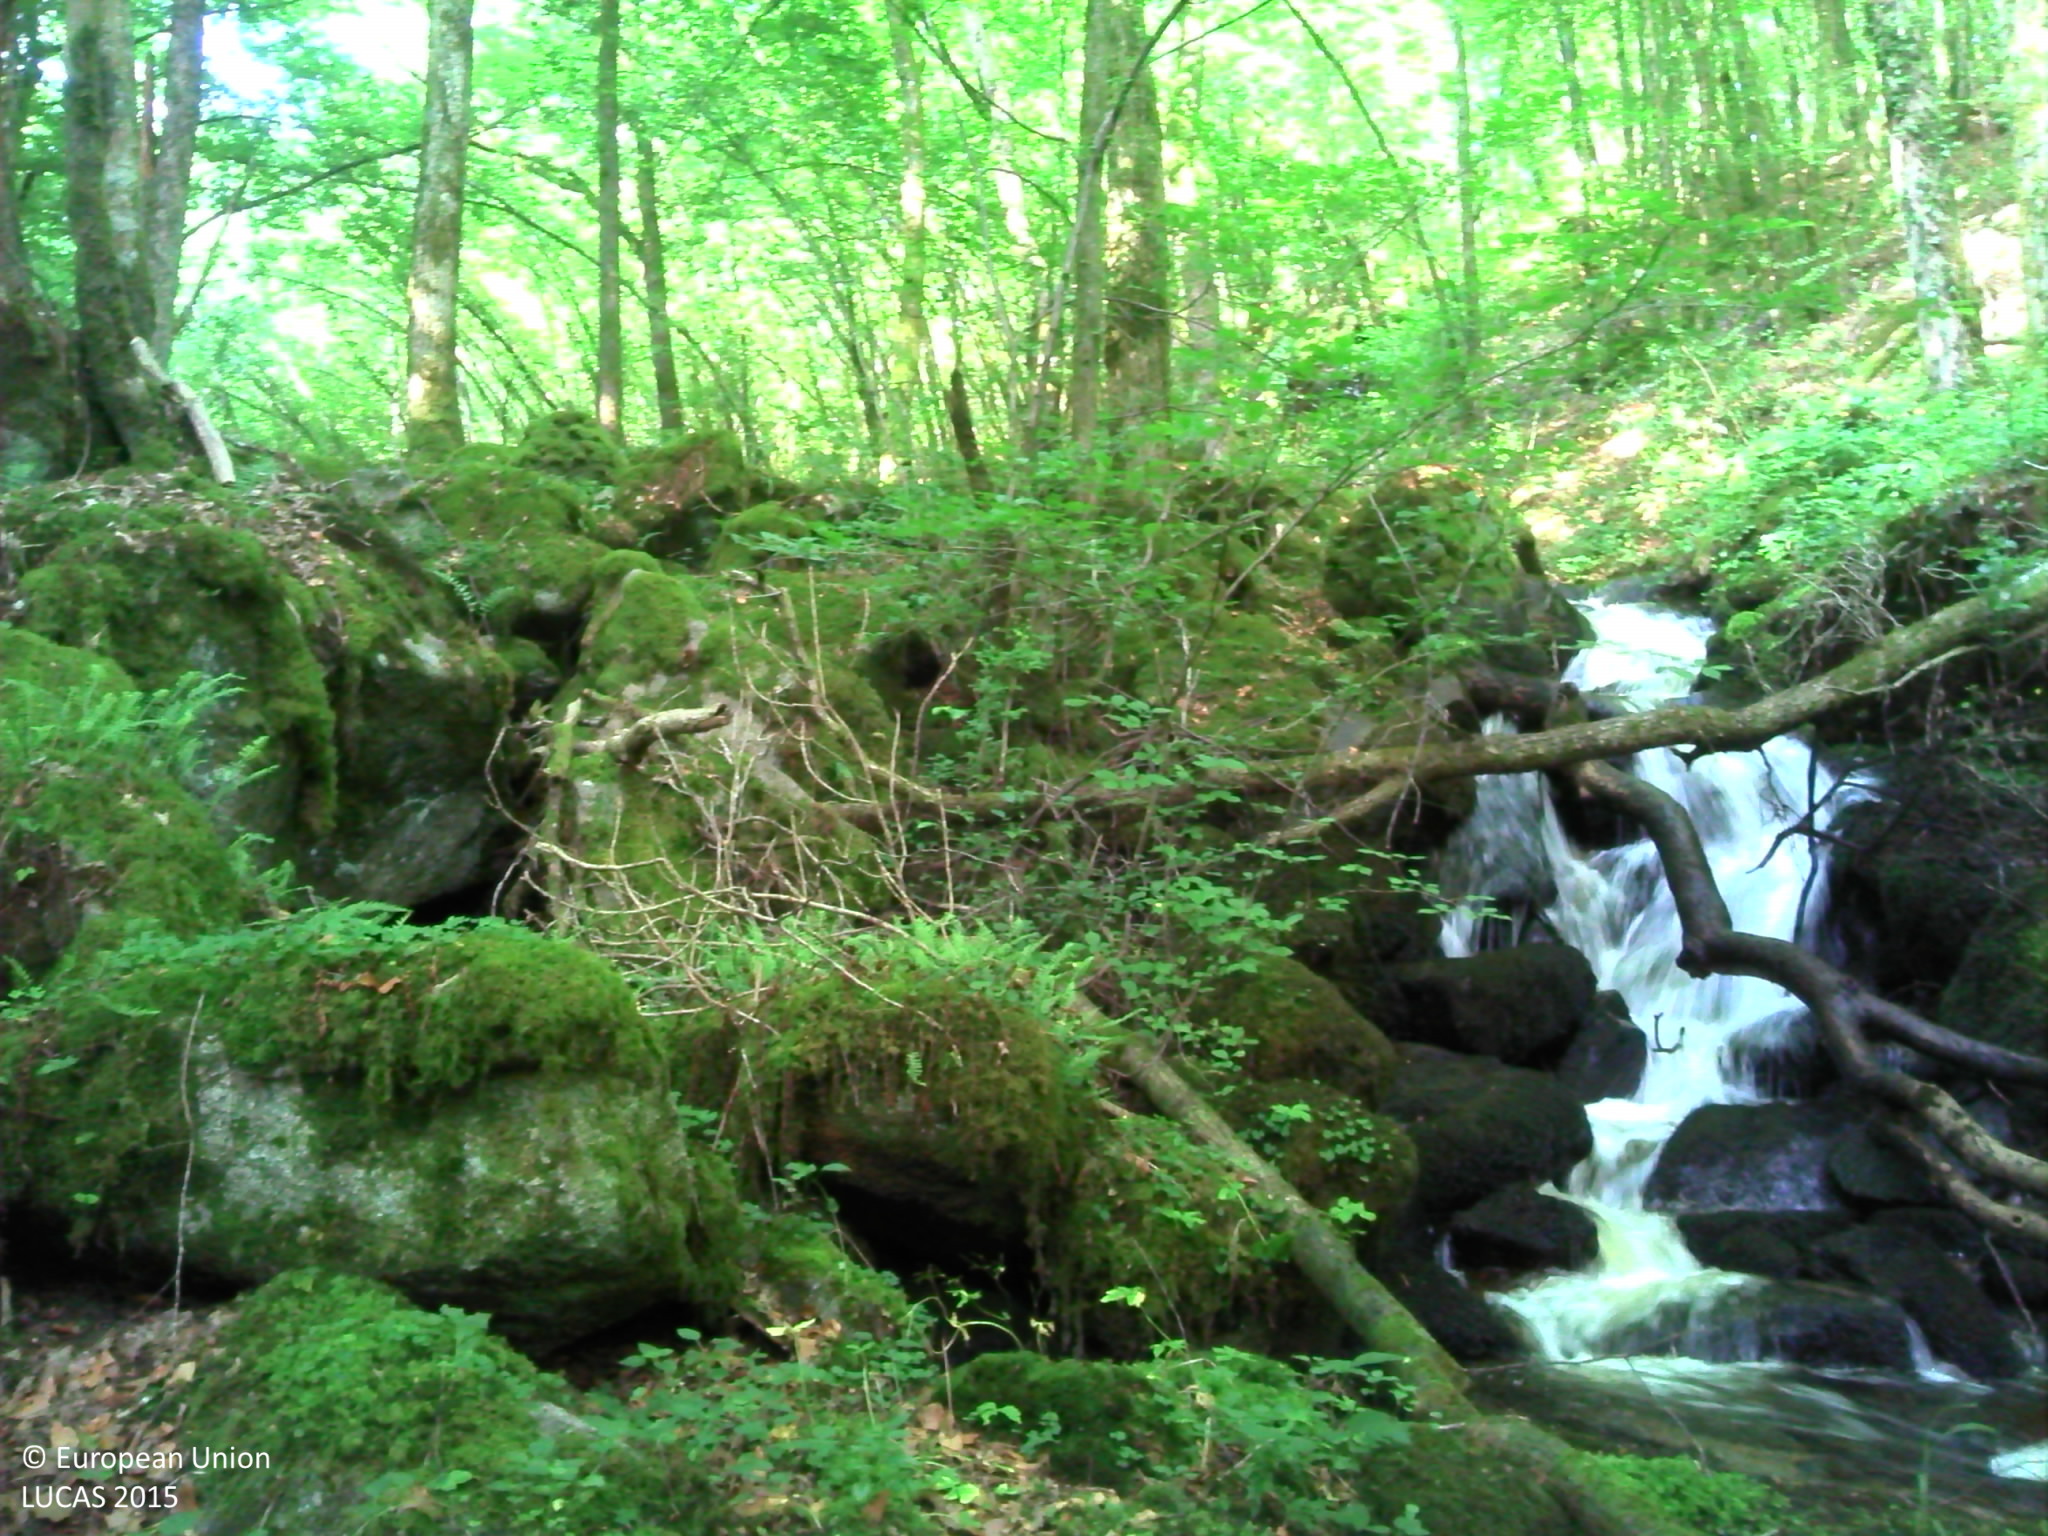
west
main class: Woodland
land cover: Broadleaved woodland
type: mesophytic deciduous forest
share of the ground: > 75 %
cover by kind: broadleaved forest trees 90 %, lichens and mosses 10 %
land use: Forestry
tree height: > 5 m
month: June
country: FR
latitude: 47.3325
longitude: 3.8973
